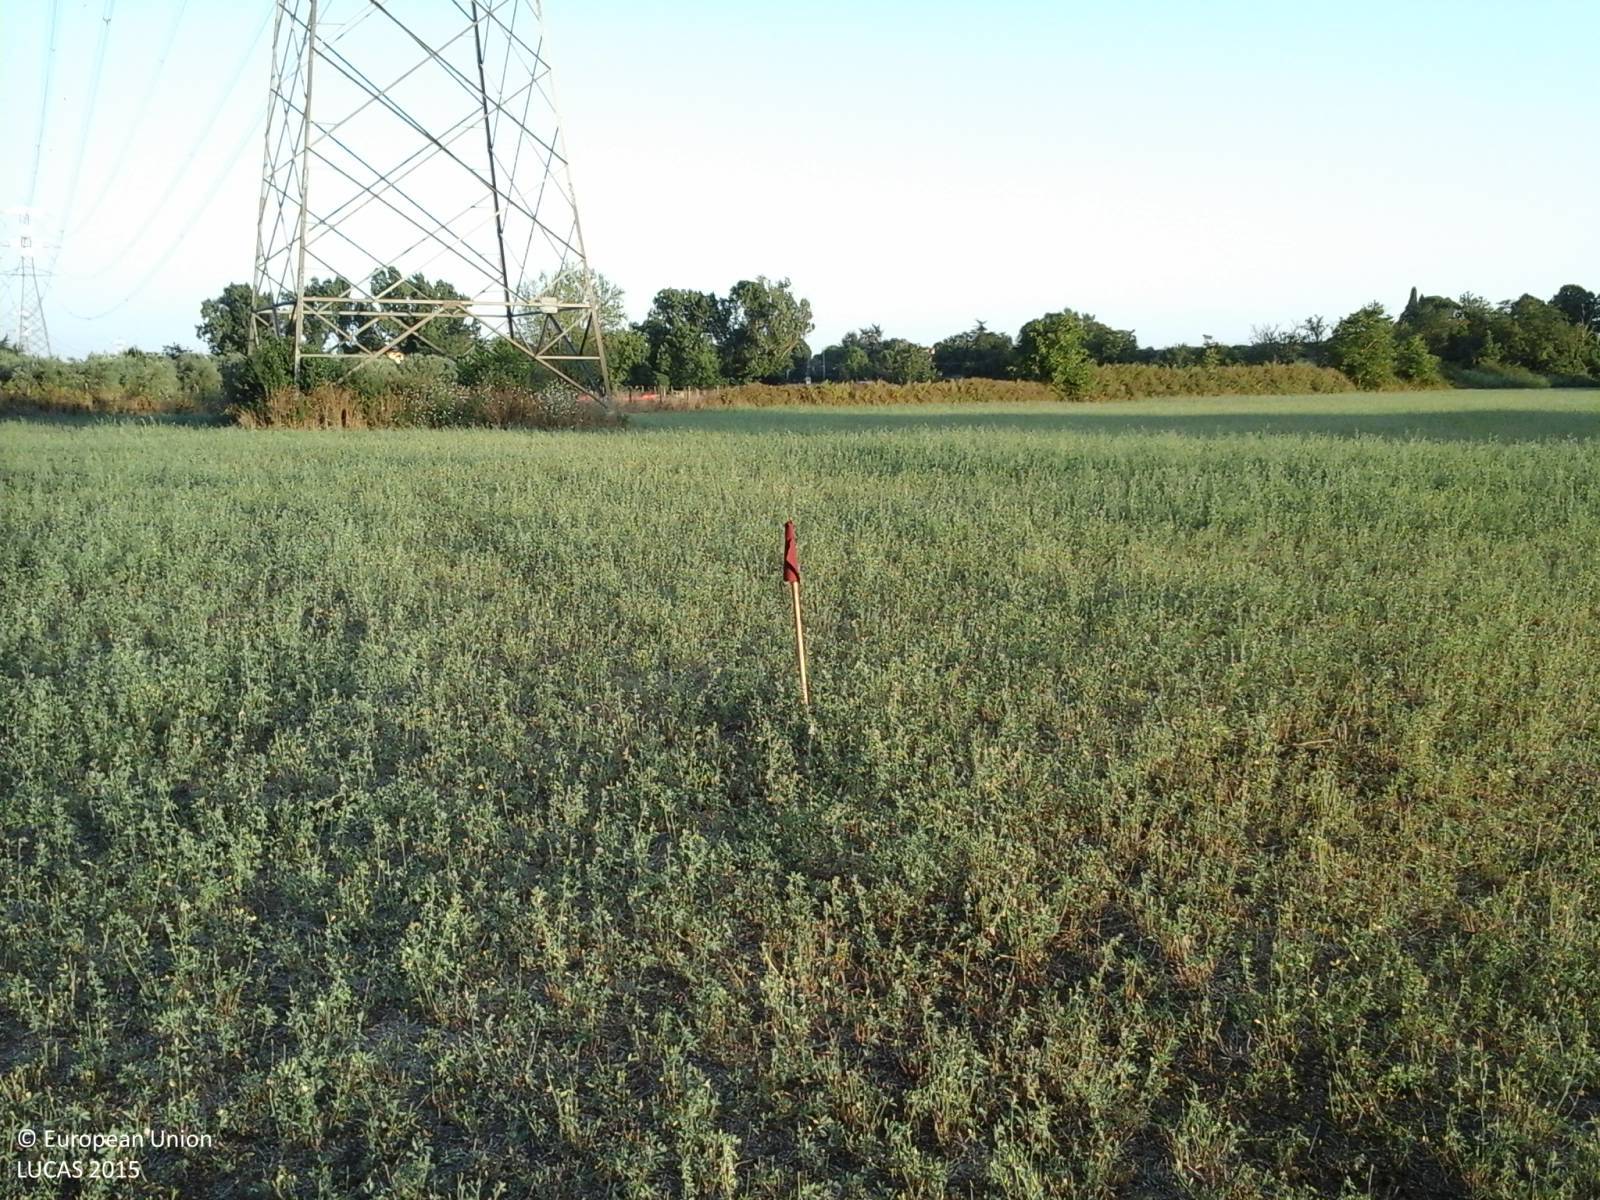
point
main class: Cropland
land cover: Lucerne
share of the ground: > 75 %
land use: Agriculture (excluding fallow land and kitchen gardens)
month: July
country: IT
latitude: 42.1335
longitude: 12.5678
